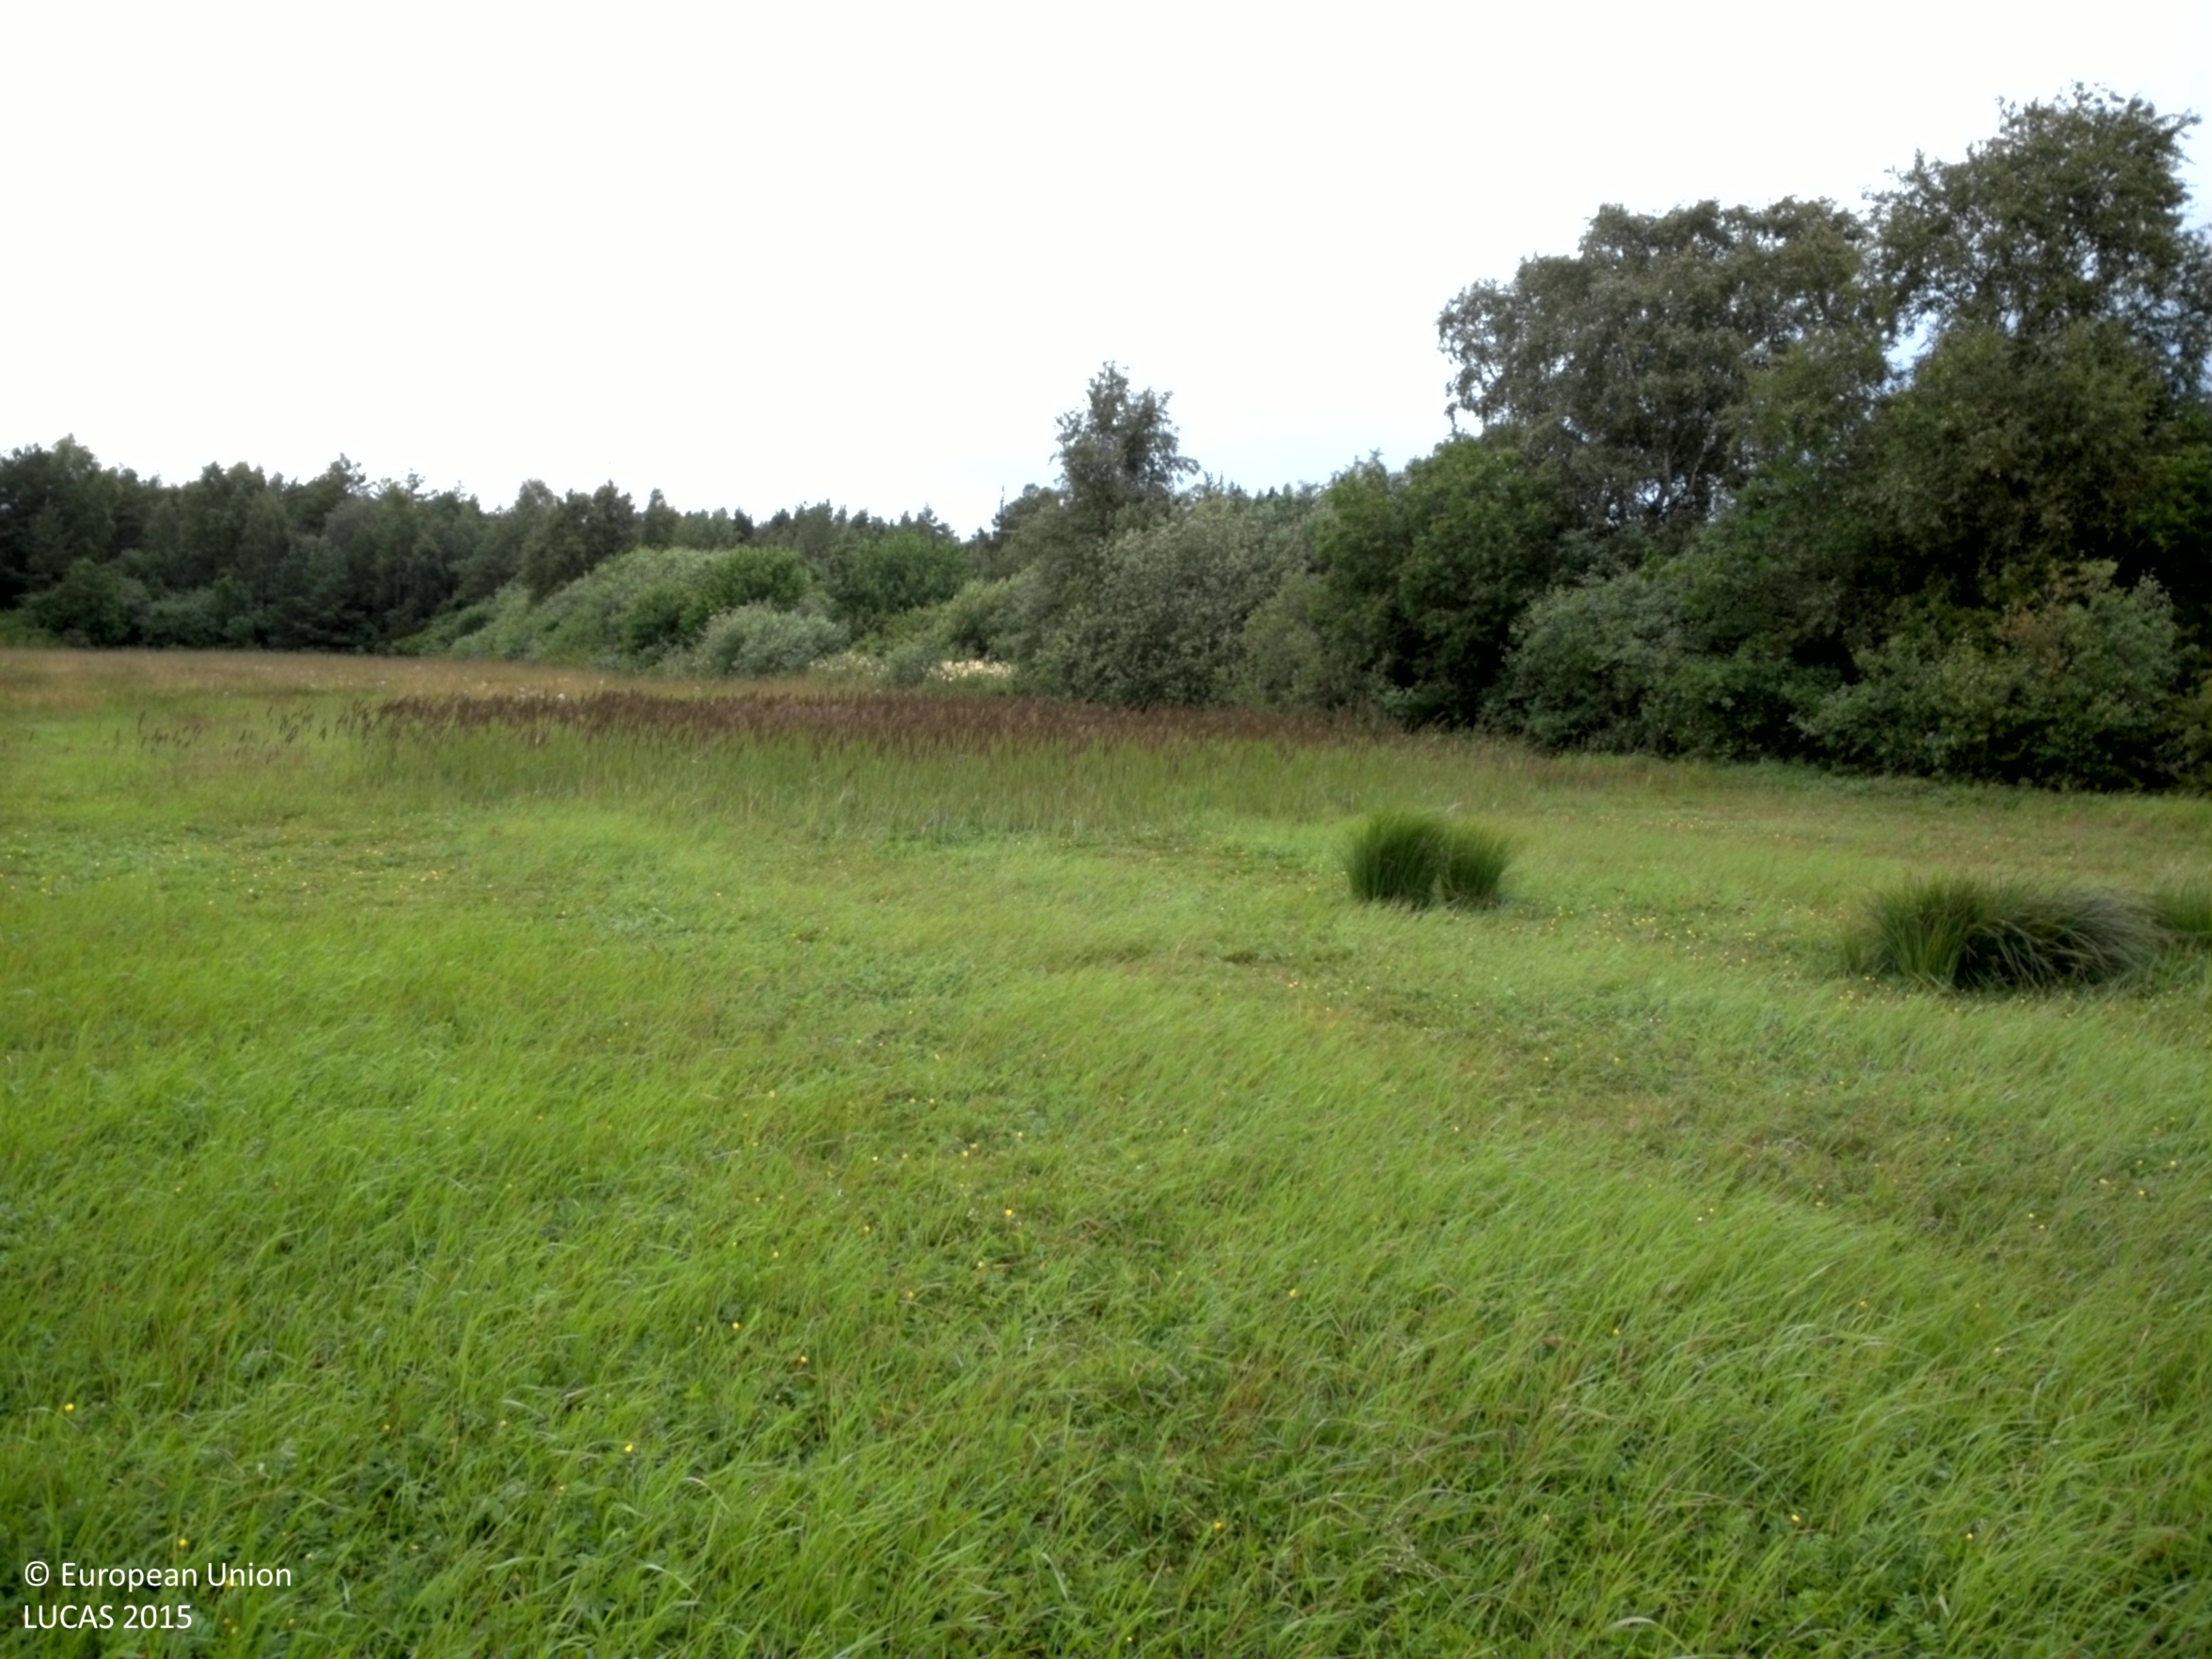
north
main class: Grassland
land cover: Grassland without tree/shrub cover
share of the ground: > 75 %
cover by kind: herbaceous plants 100 %
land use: Agriculture (excluding fallow land and kitchen gardens)
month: July
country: SE
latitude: 57.4429
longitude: 18.2211
